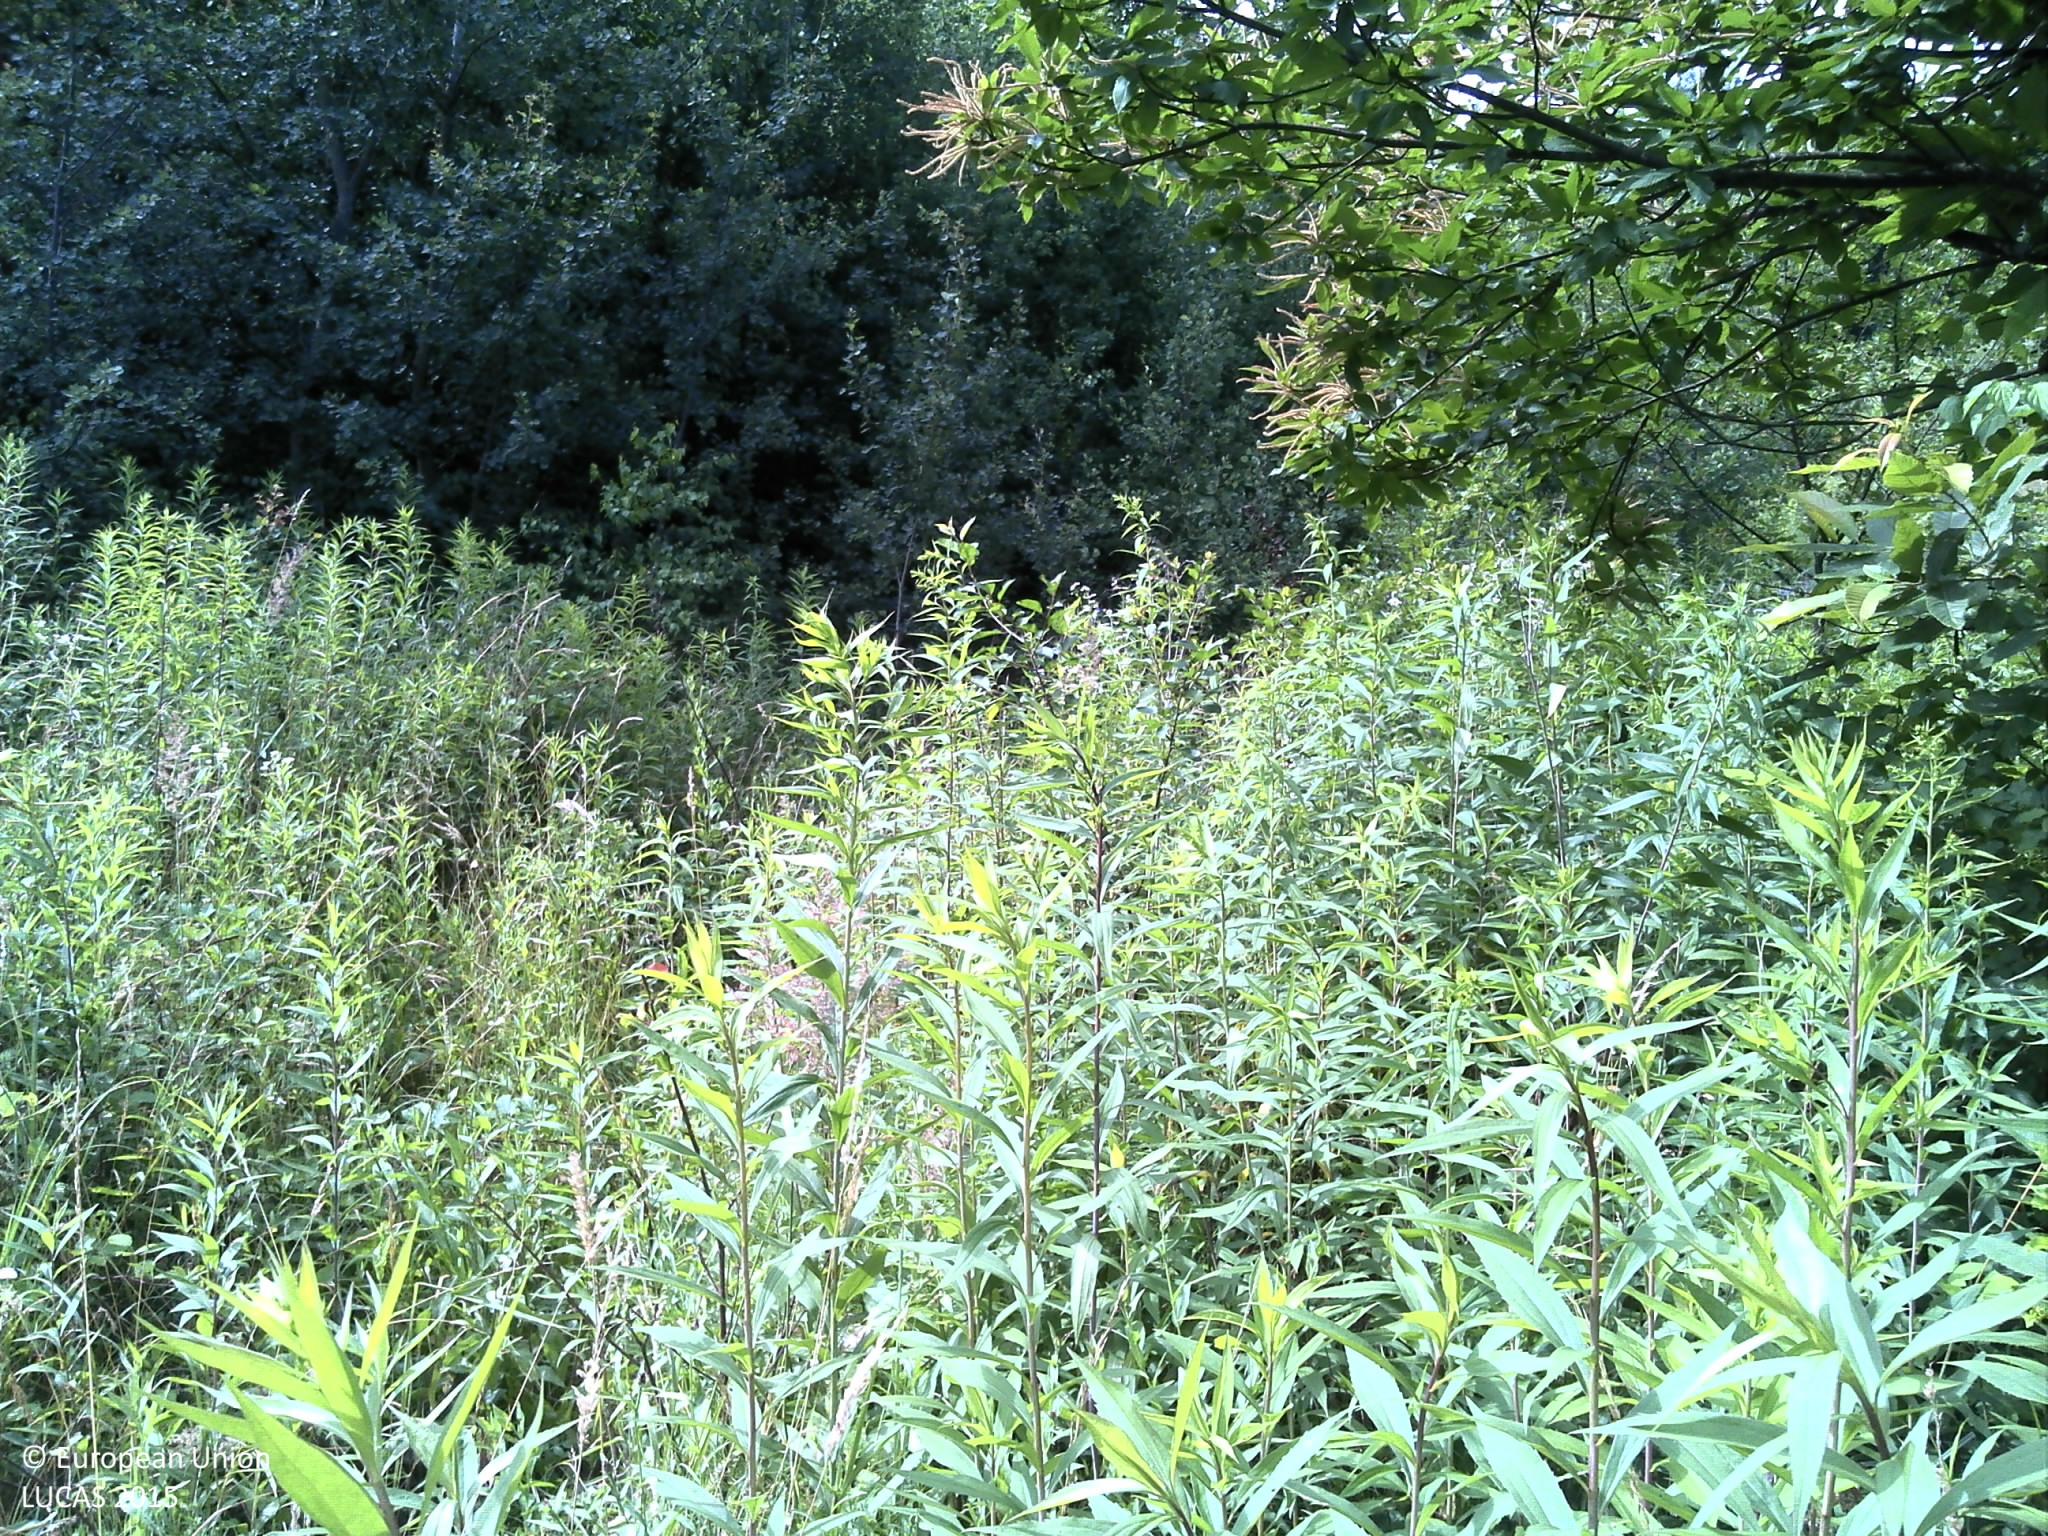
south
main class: Grassland
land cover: Spontaneously vegetated surfaces
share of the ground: > 75 %
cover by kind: herbaceous plants 100 %
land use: Fallow land
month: June
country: HR
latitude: 45.7873
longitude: 17.3985
